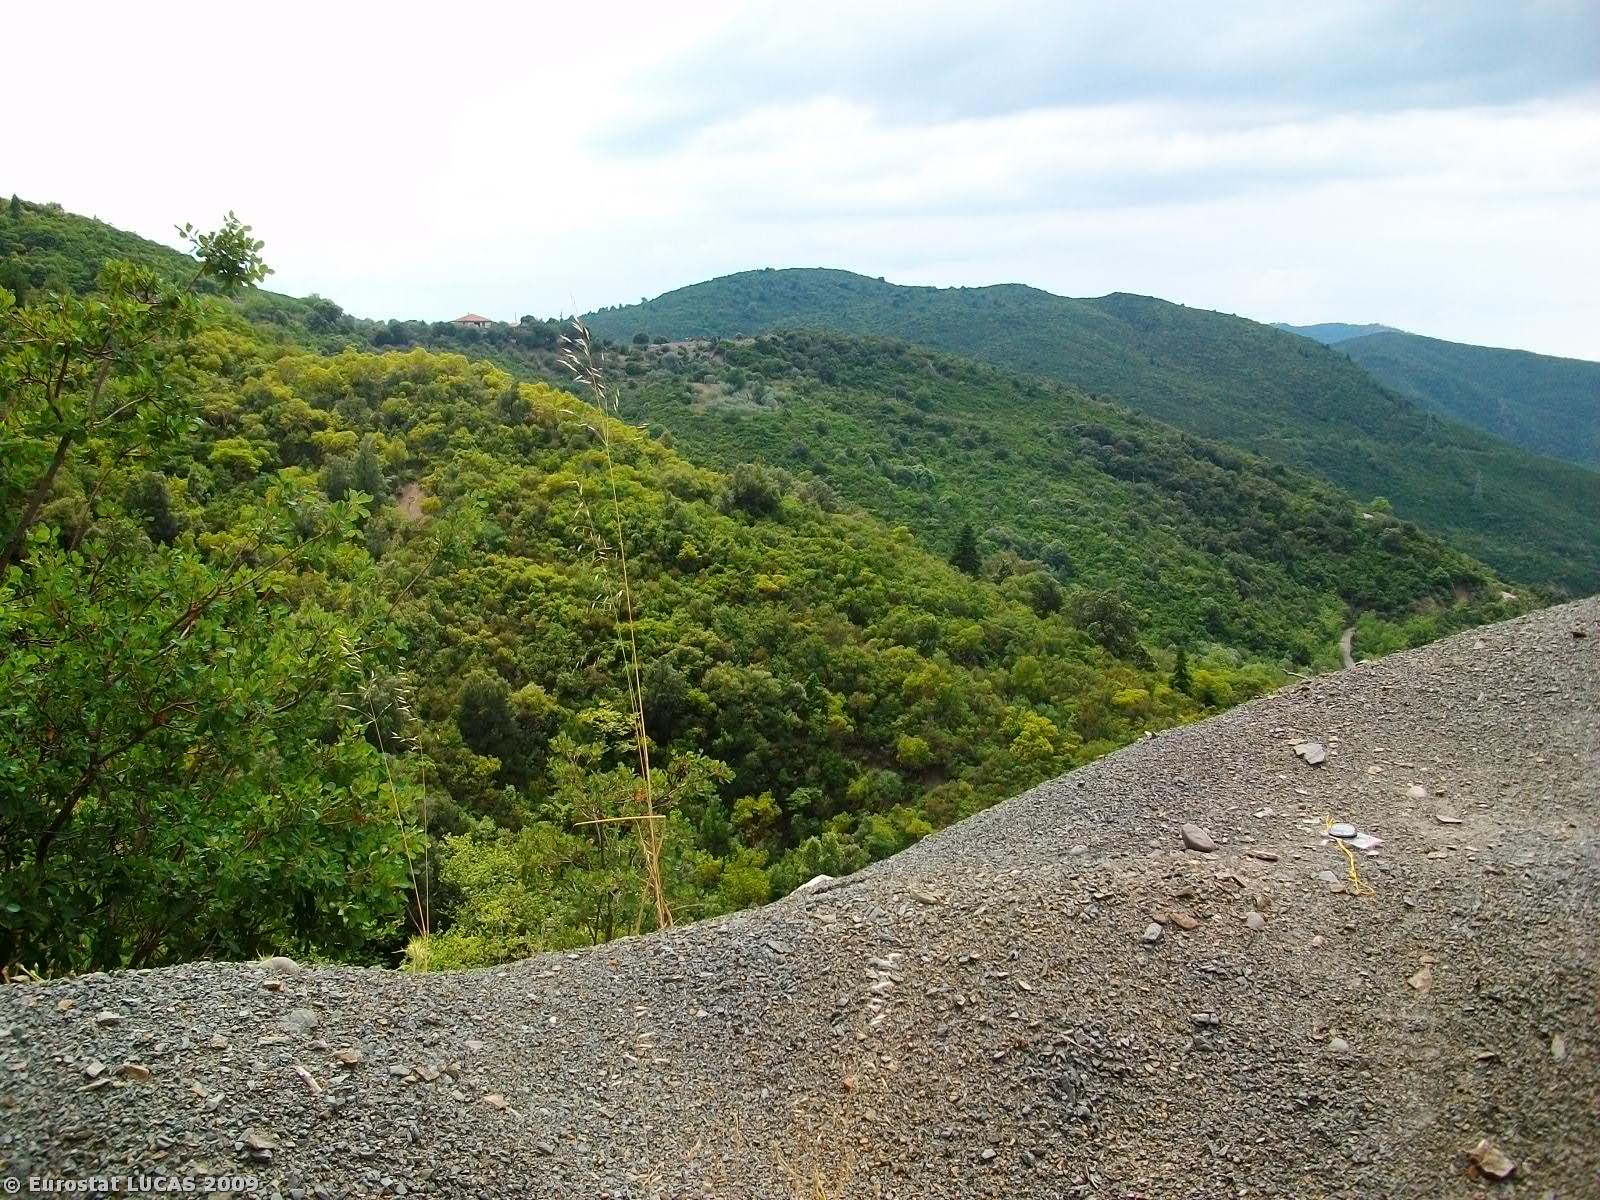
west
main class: Woodland
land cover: Broadleaved woodland
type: thermophilous deciduous forest
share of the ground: > 75 %
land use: Forestry
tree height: > 5 m
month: June
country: GR
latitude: 38.8695
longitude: 21.5570
